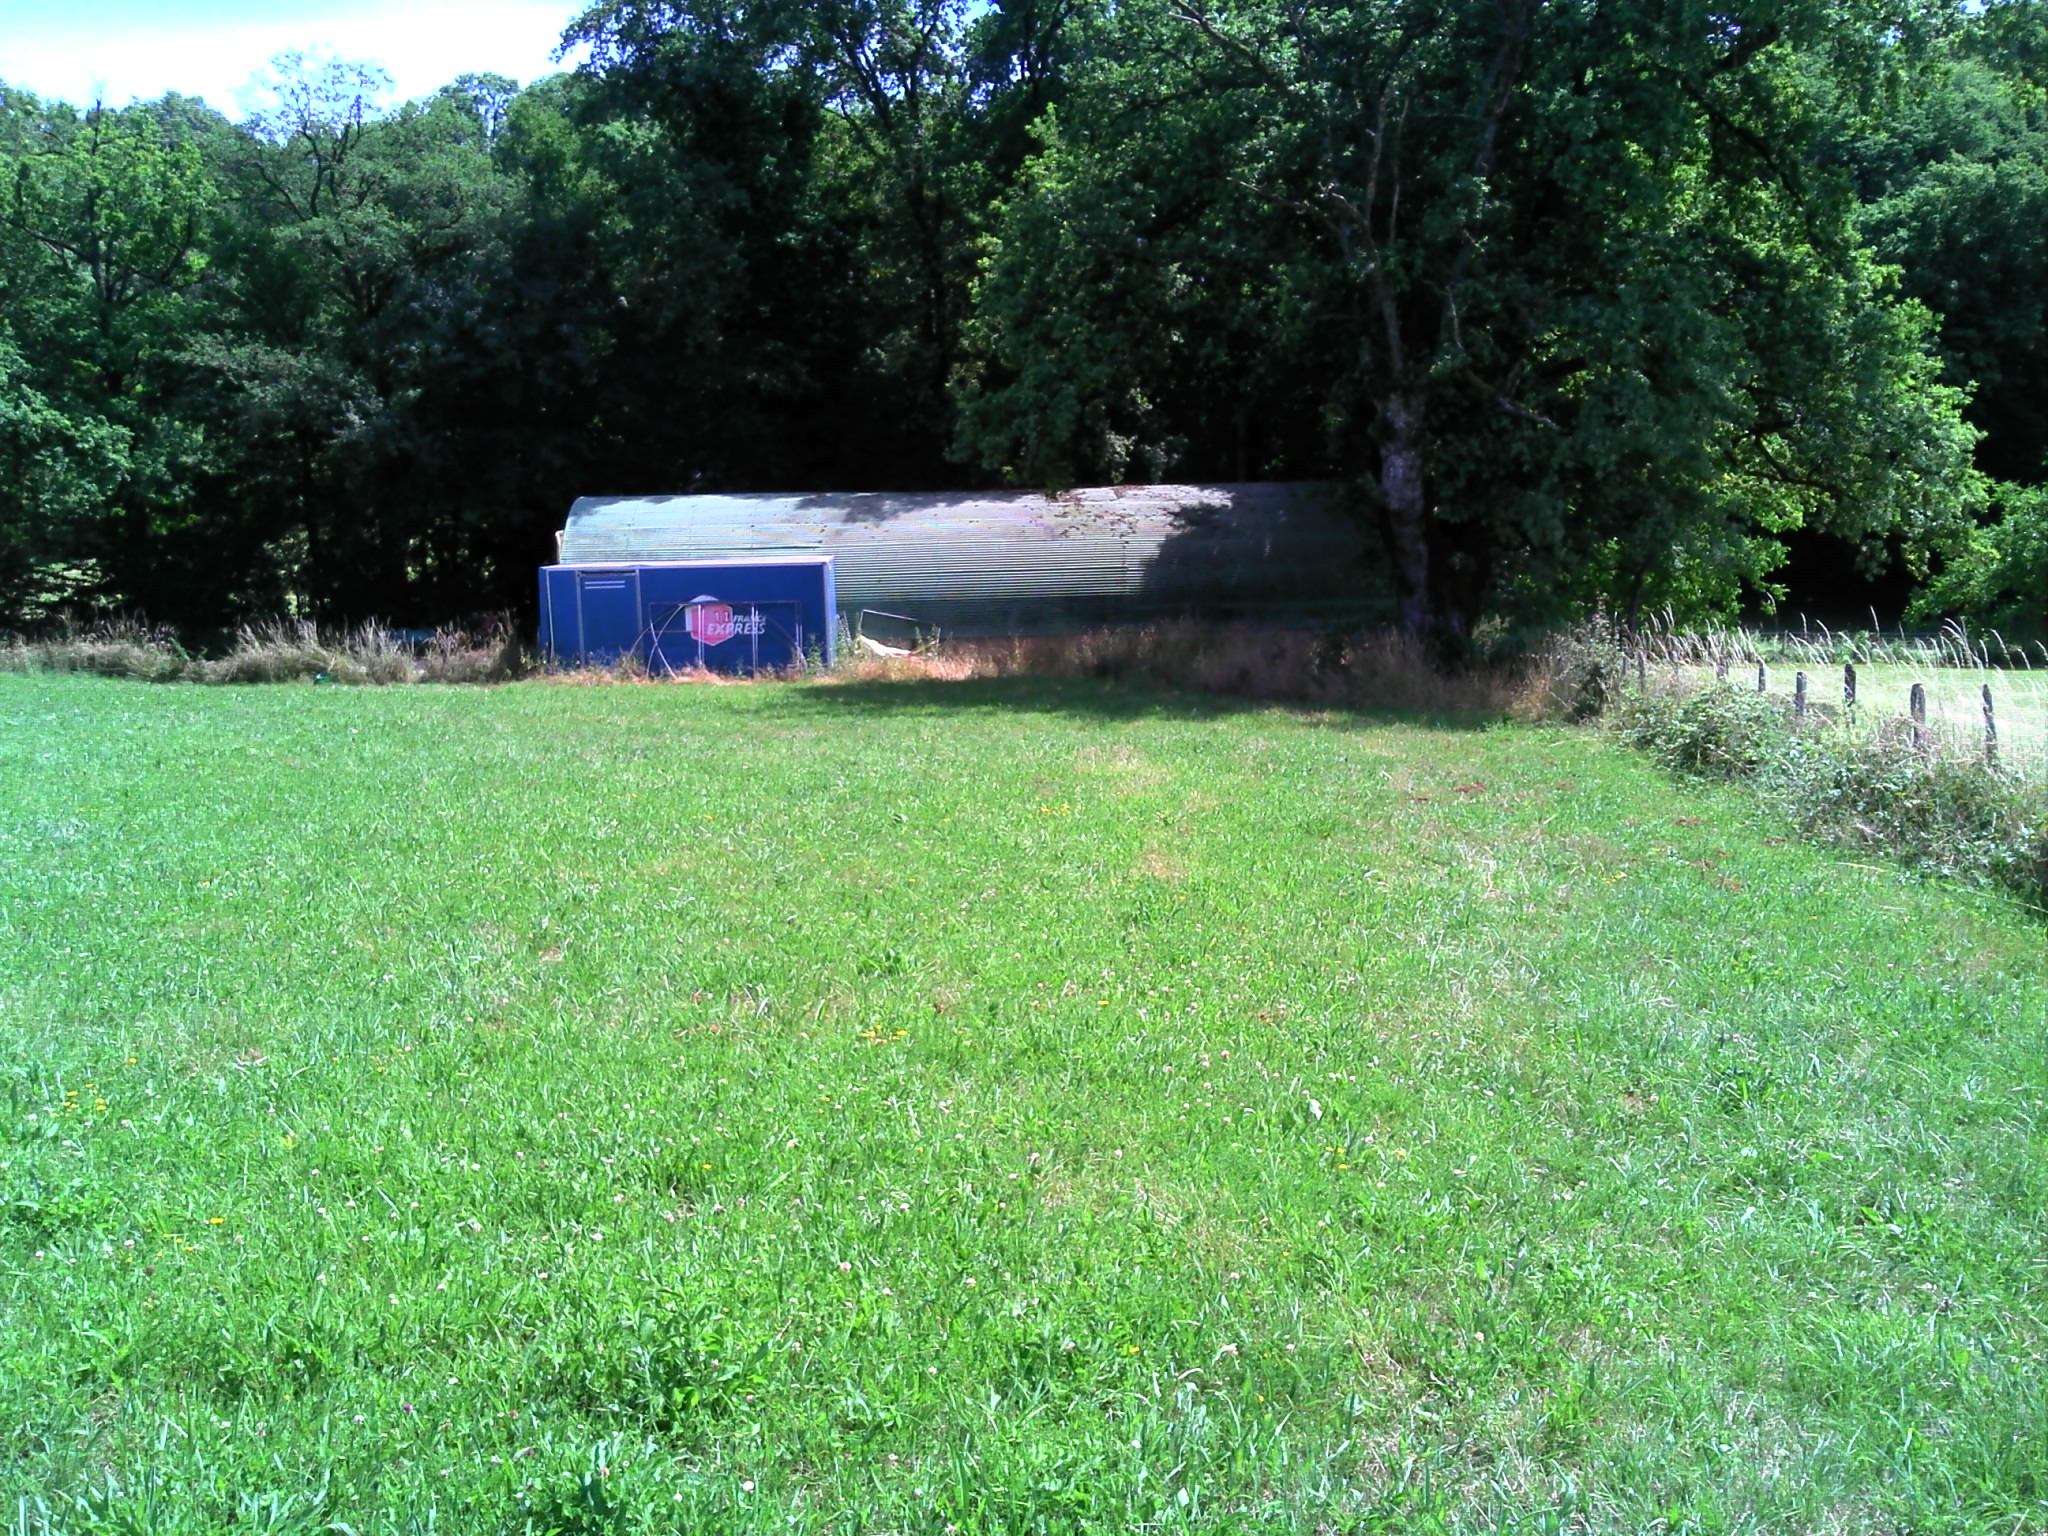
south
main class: Grassland
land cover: Grassland without tree/shrub cover
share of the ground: > 75 %
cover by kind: herbaceous plants 100 %
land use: Agriculture (excluding fallow land and kitchen gardens)
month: June
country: FR
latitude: 44.8201
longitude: 1.7652
